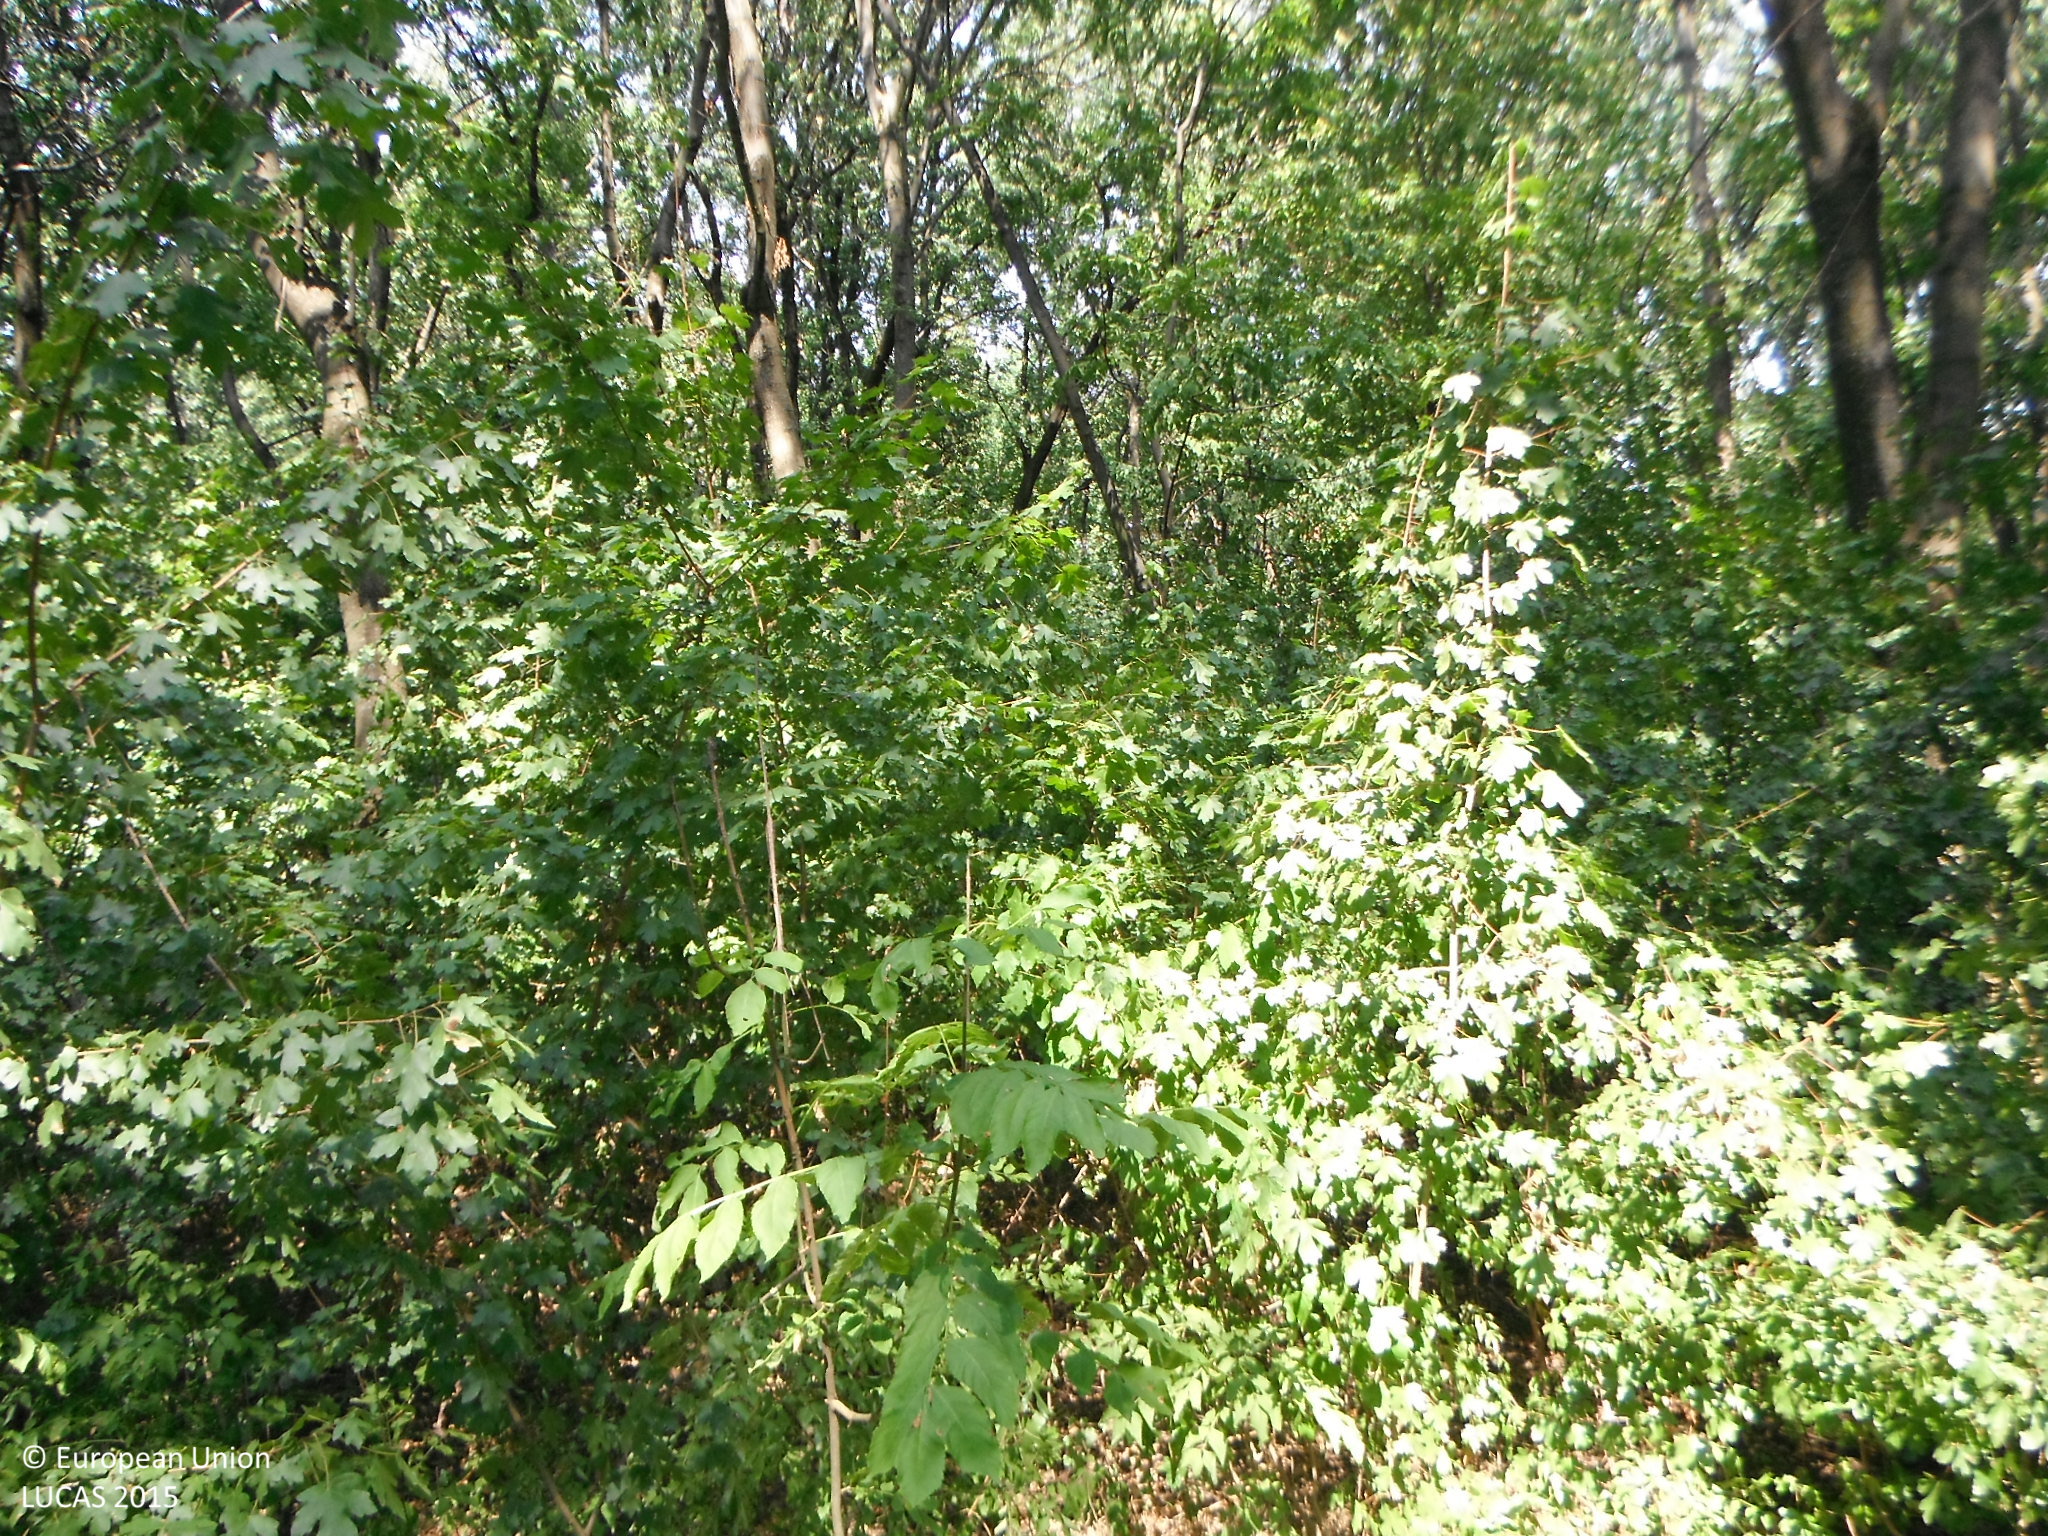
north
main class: Woodland
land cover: Broadleaved woodland
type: mesophytic deciduous forest
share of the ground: > 75 %
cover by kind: broadleaved forest trees 95 %, shrubs 5 %
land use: Forestry
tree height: > 5 m
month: August
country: SK
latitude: 48.3671
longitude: 17.9908
